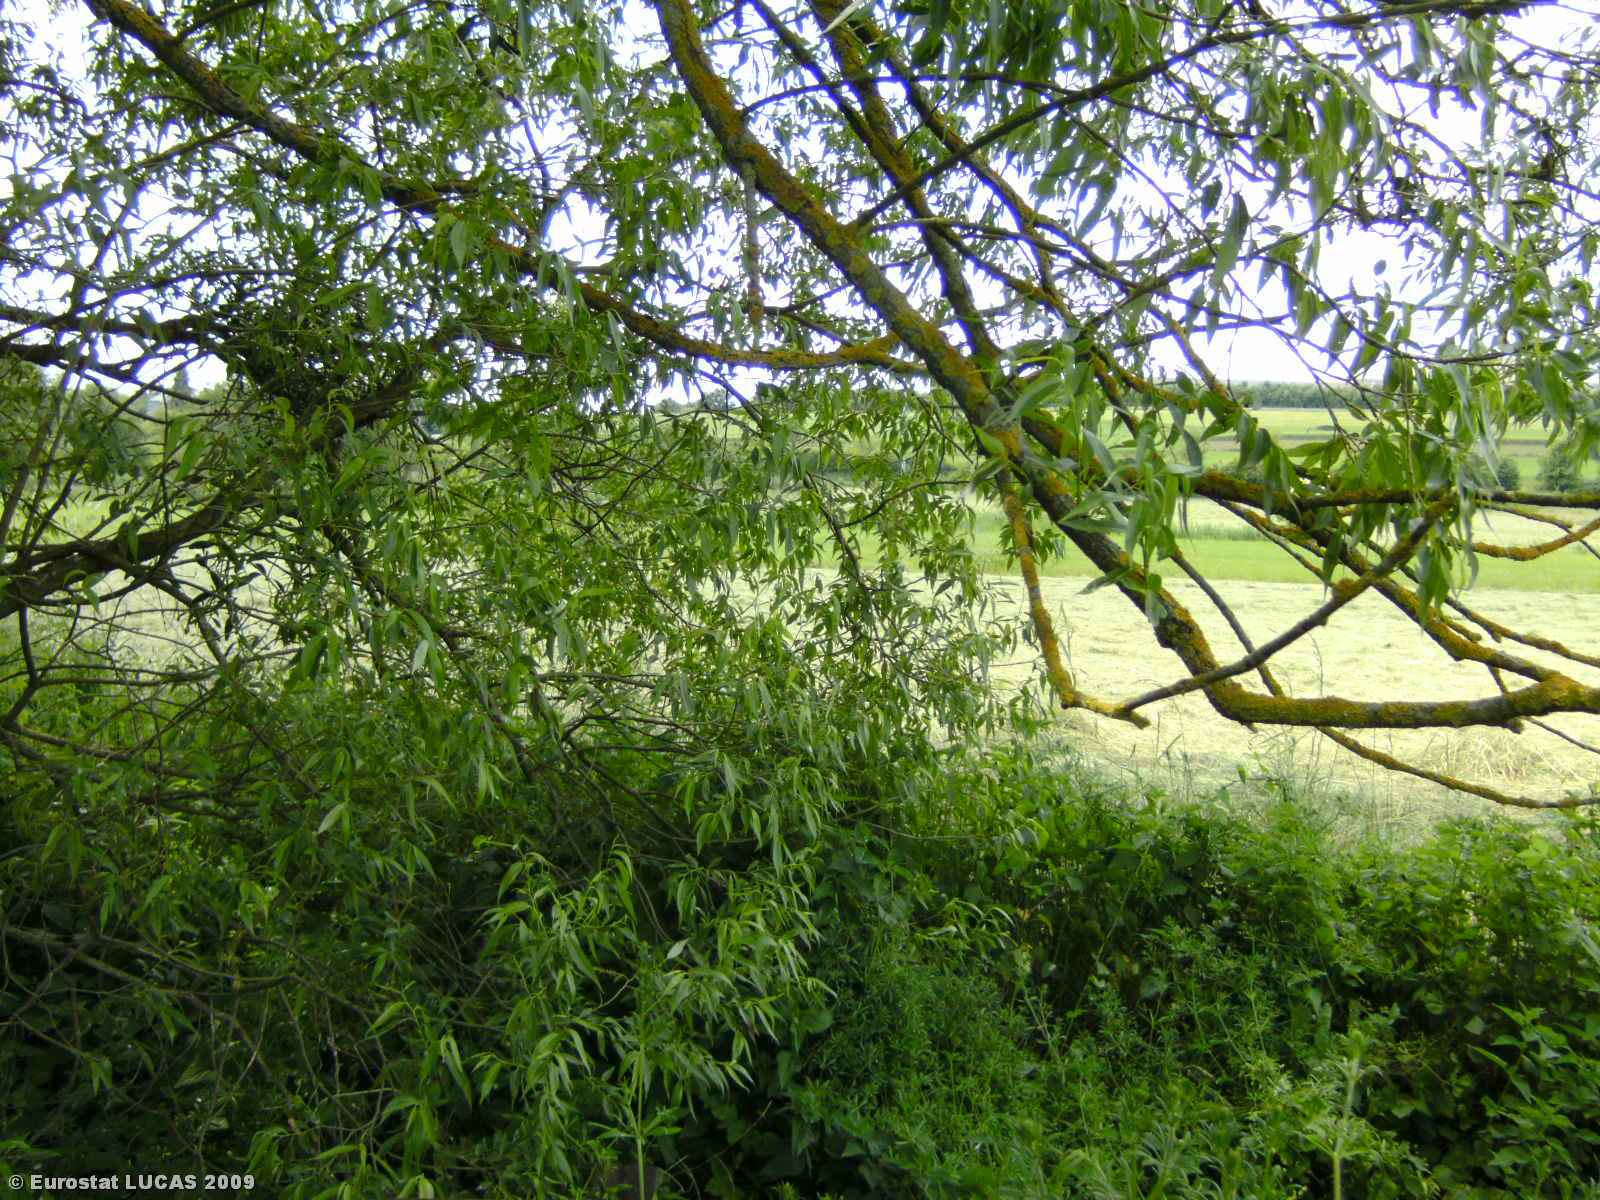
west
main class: Woodland
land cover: Broadleaved woodland
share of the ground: 10 - 25 %
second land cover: Grassland with sparse tree/shrub cover
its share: > 75 %
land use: Agriculture (excluding fallow land and kitchen gardens)
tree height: > 5 m
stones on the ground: < 10 %
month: June
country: LU
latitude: 49.6562
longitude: 6.3010
